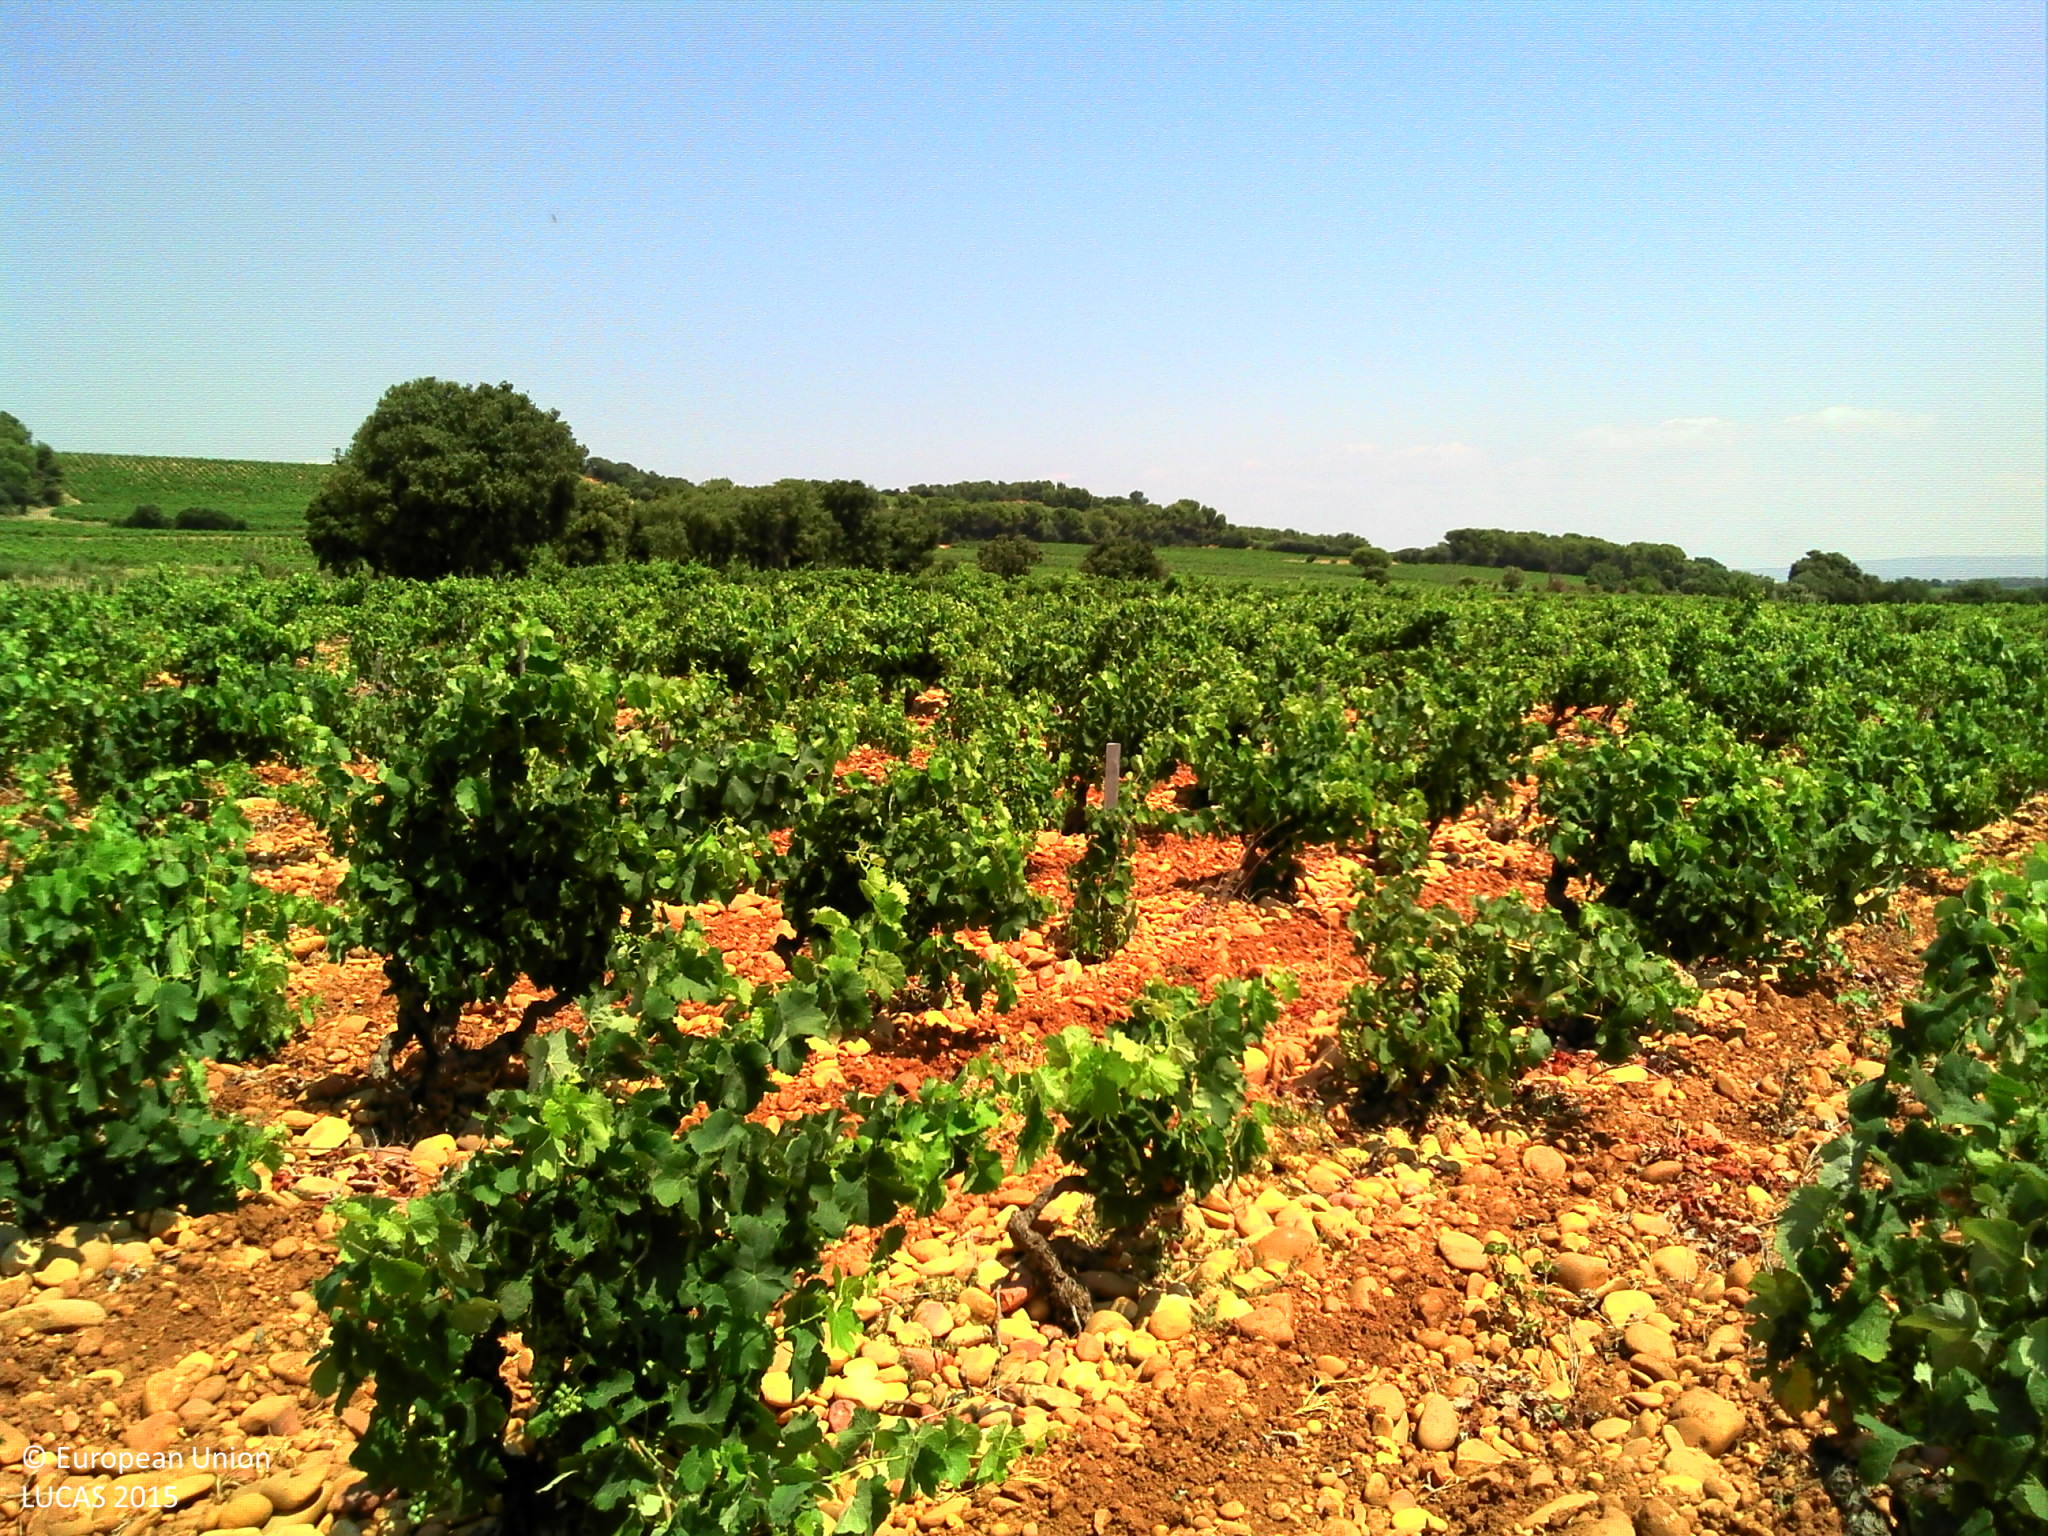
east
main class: Cropland
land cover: Vineyards
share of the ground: 25 - 50 %
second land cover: Sand
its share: > 75 %
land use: Agriculture (excluding fallow land and kitchen gardens)
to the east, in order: Vineyards; Sand; Tracks; Vineyards; Tracks; Grass margins; Managed hedges; Vineyards; Grass margins; Managed hedges; Paved roads, cycling and walking lanes; Vineyards
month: July
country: FR
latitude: 44.0422
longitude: 4.8542
